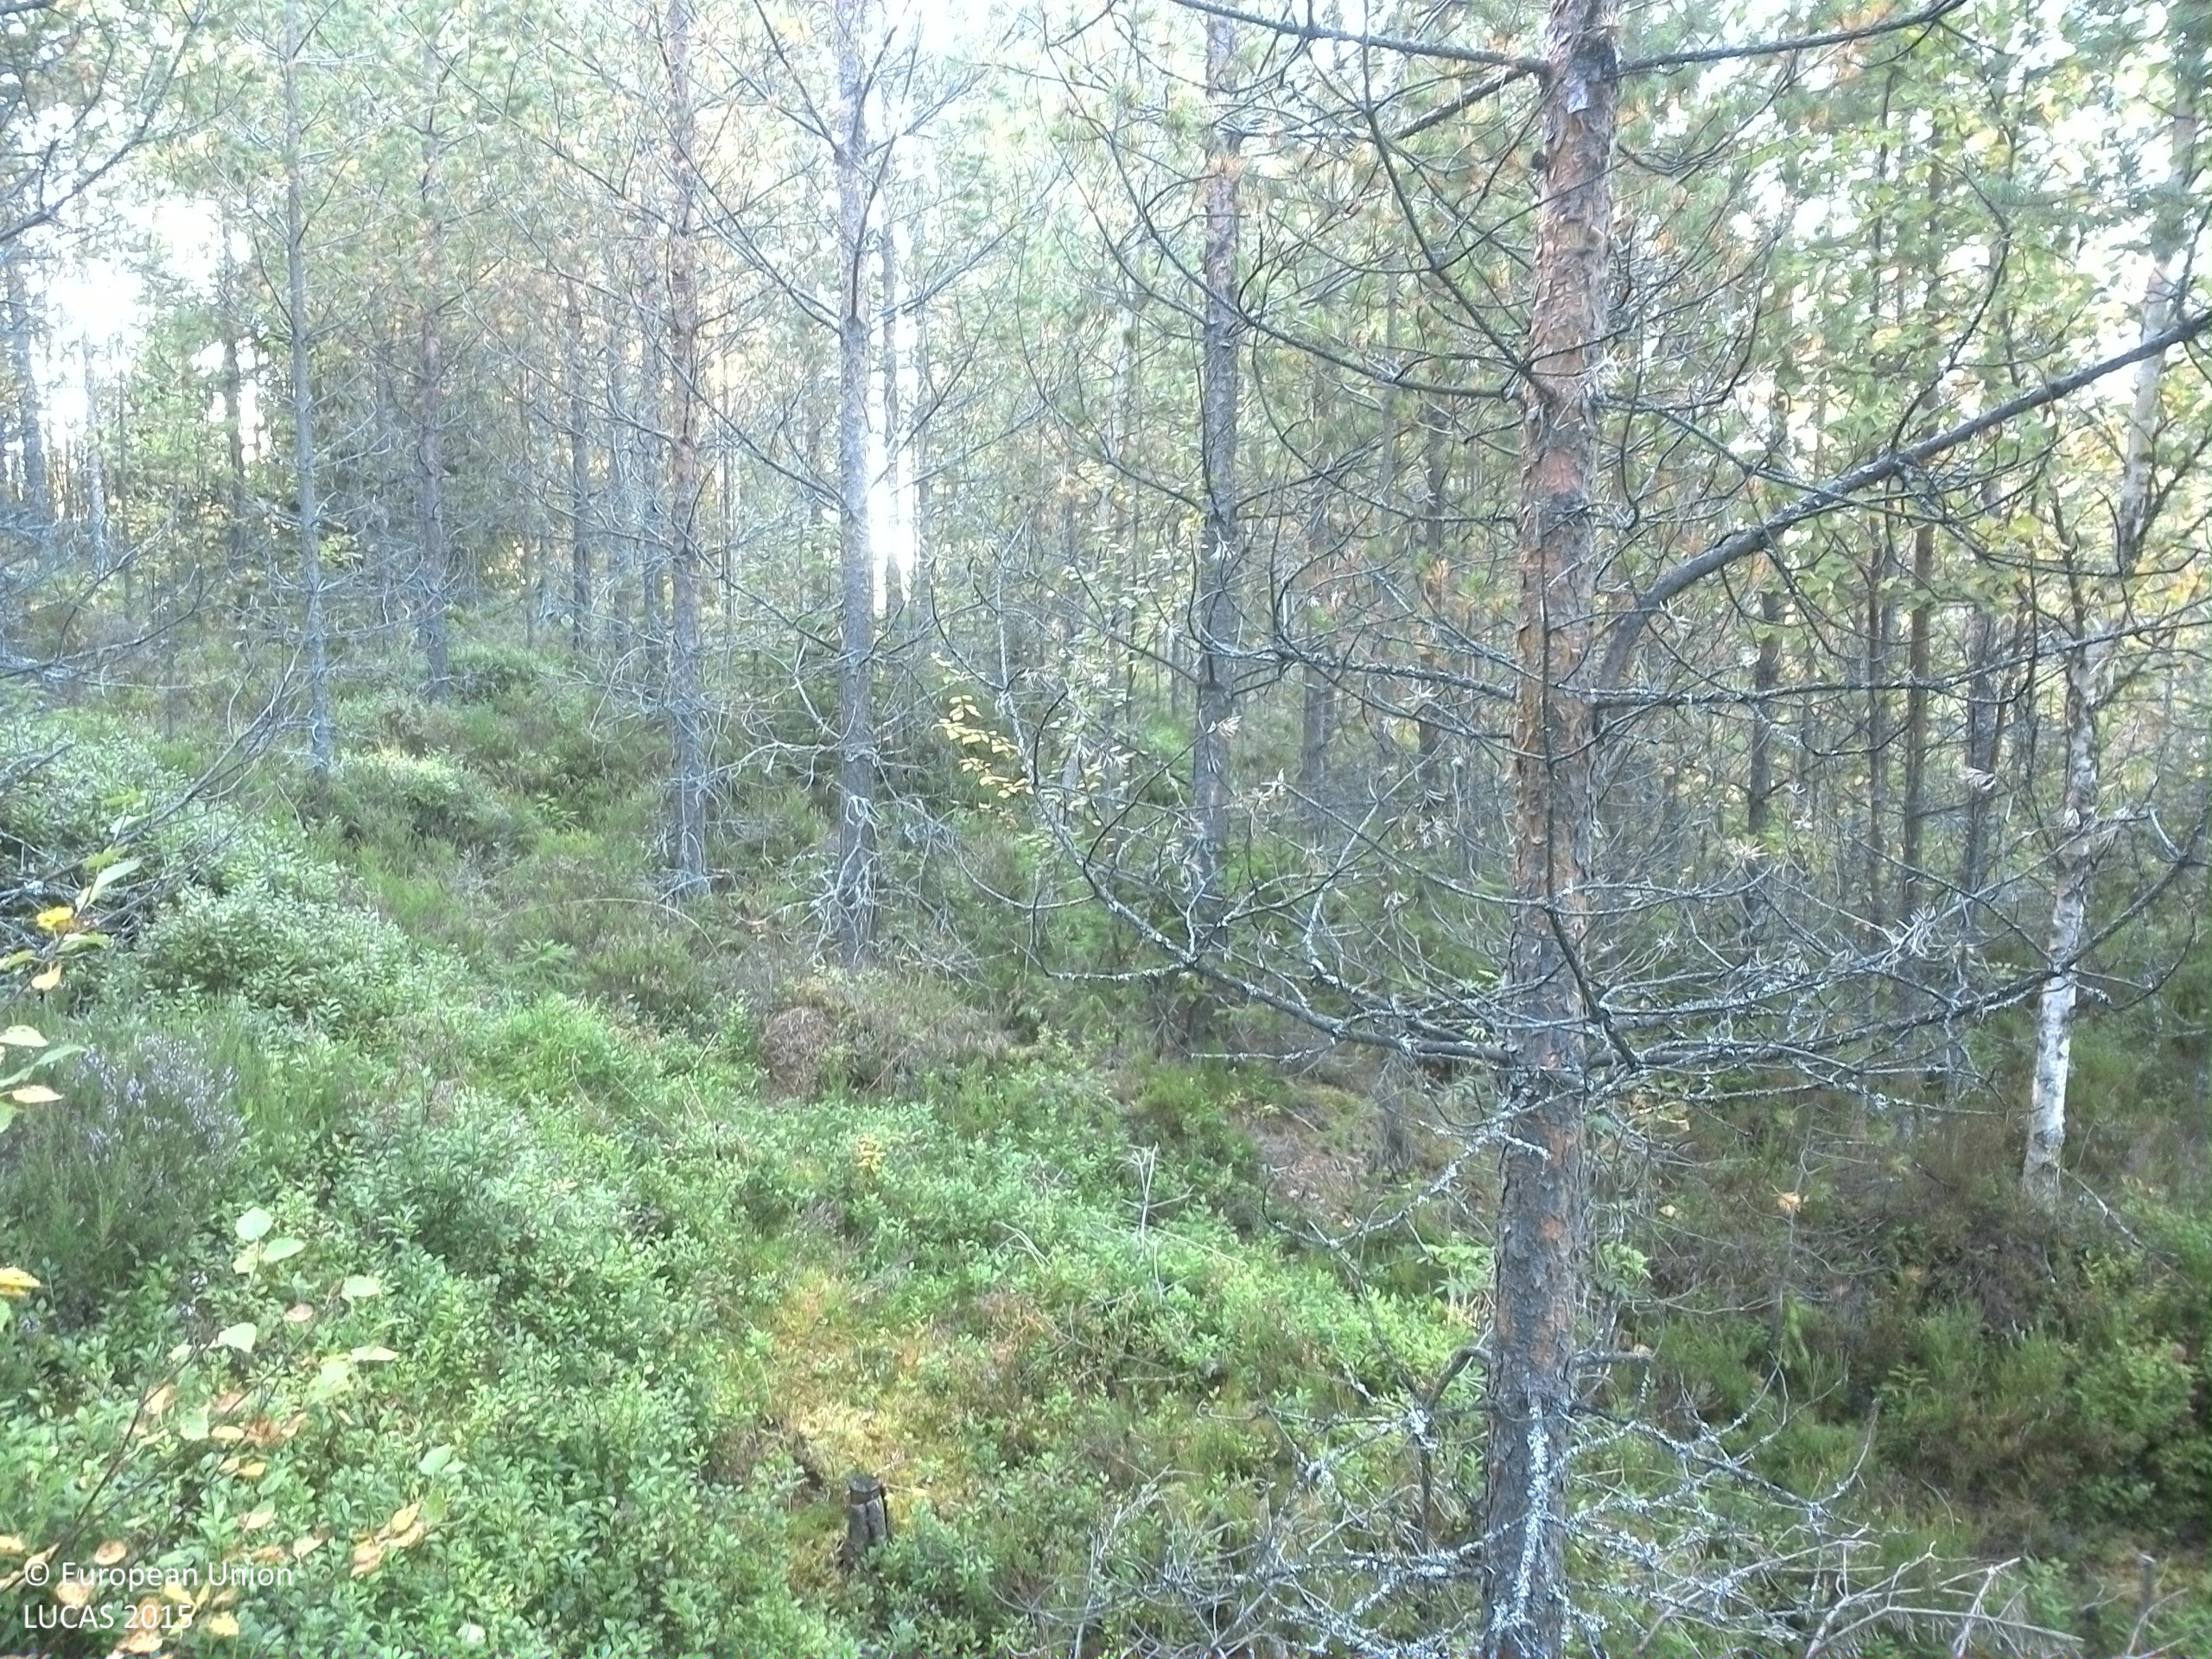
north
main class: Woodland
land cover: Pine dominated coniferous woodland
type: boreal forest
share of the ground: > 75 %
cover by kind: coniferous forest trees 75 %, shrubs 20 %, lichens and mosses 5 %
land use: Forestry
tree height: > 5 m
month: September
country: SE
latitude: 61.7433
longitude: 15.2660
